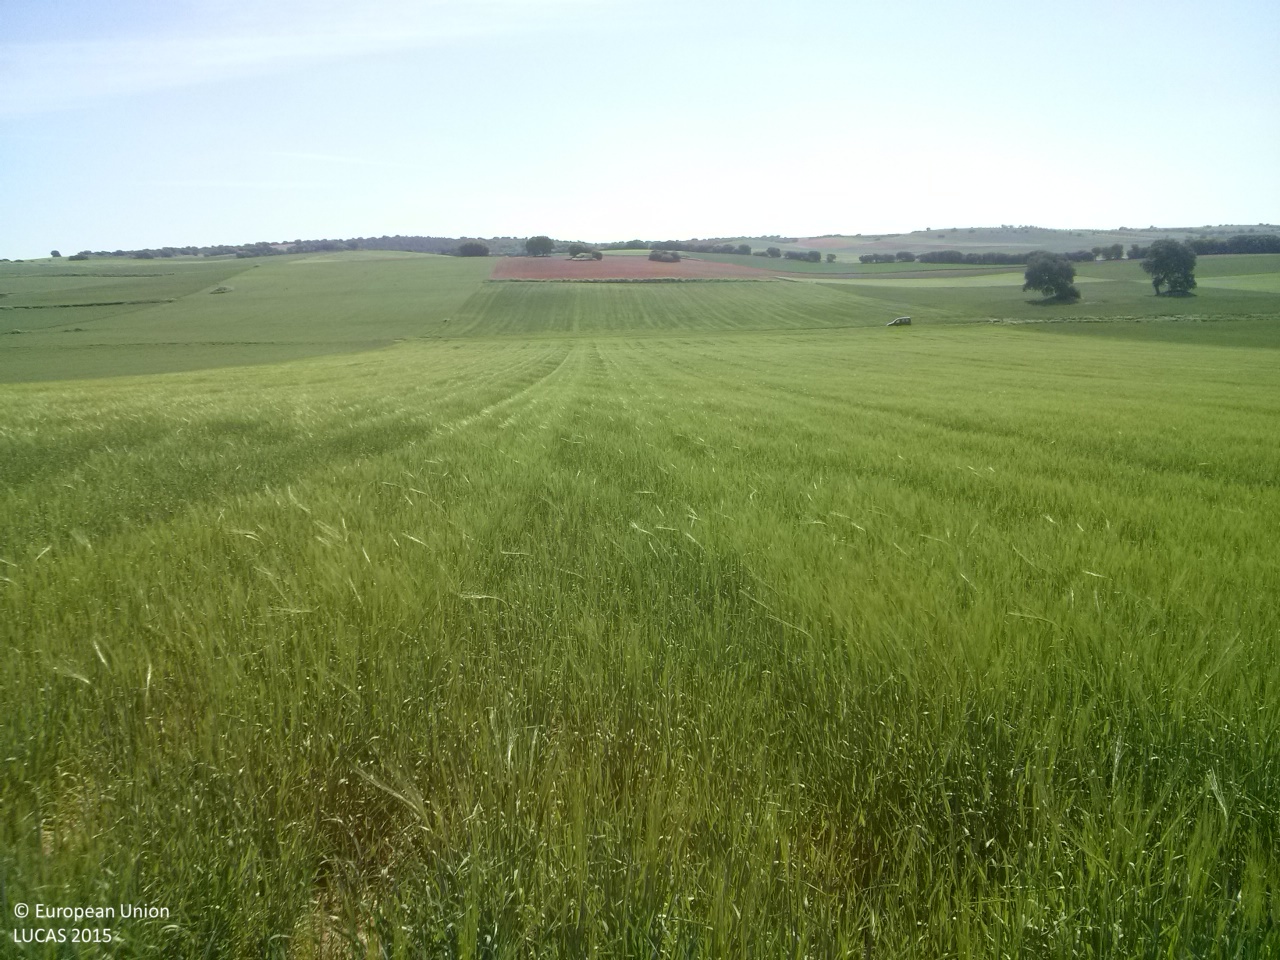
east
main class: Cropland
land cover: Barley
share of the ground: > 75 %
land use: Agriculture (excluding fallow land and kitchen gardens)
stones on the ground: 10 - 25 %
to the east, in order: Barley; Grass margins; Tracks; Grass margins; Barley
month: May
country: ES
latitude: 39.8616
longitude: -2.8201
